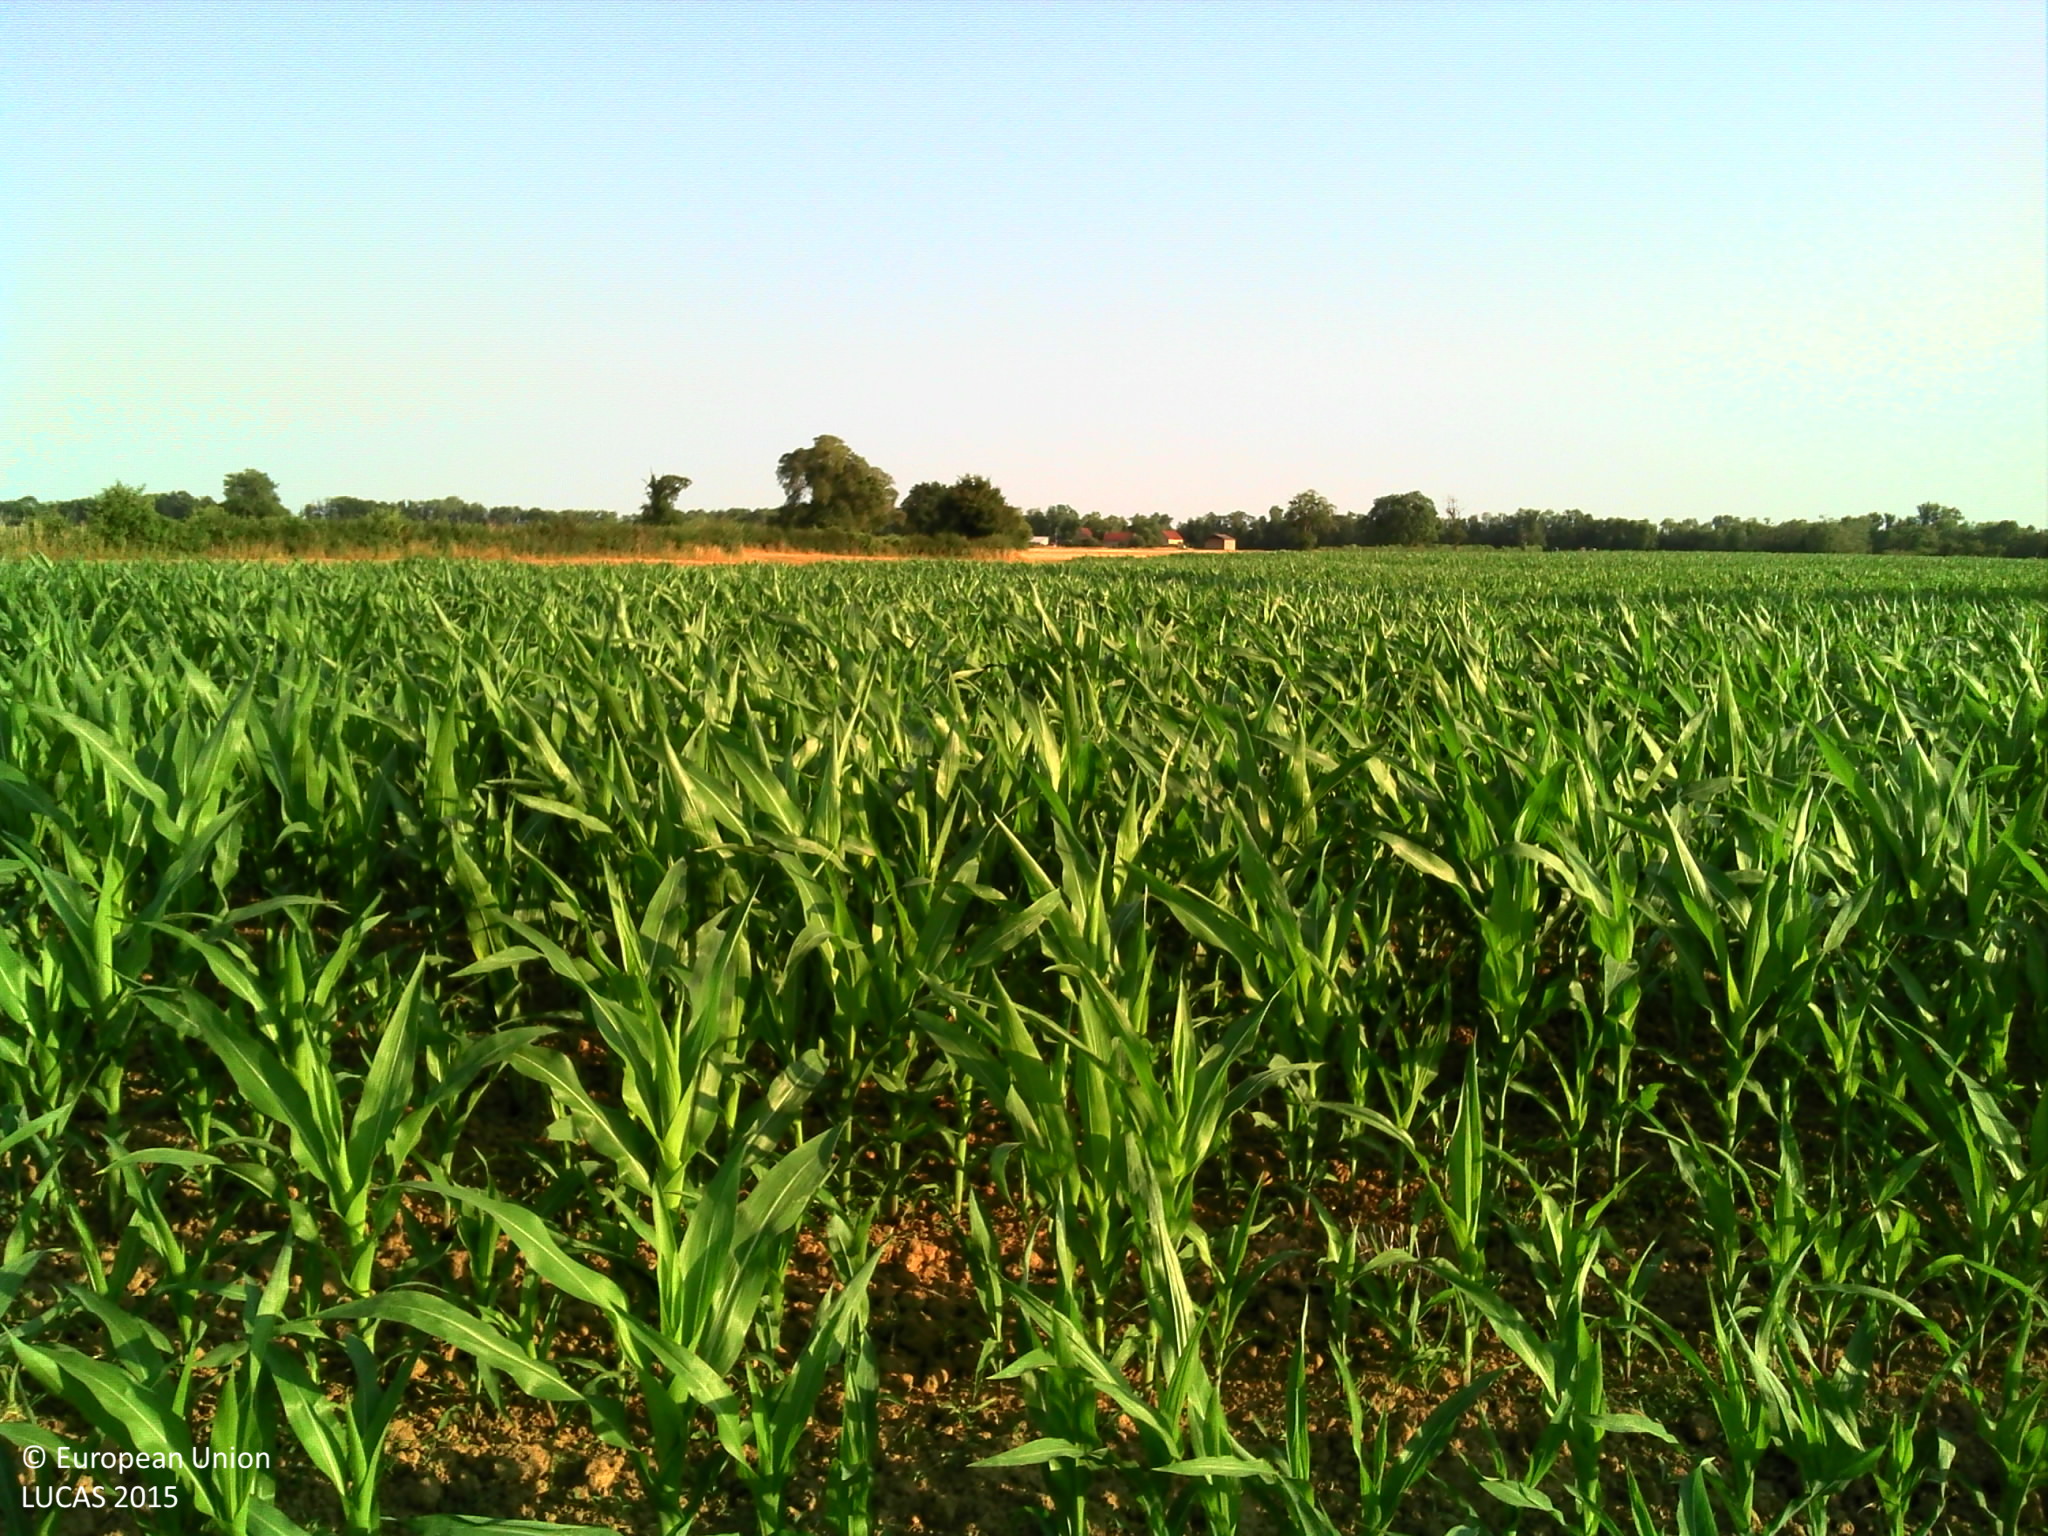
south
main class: Cropland
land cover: Maize
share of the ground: > 75 %
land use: Agriculture (excluding fallow land and kitchen gardens)
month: July
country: FR
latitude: 46.7897
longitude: 3.5662
